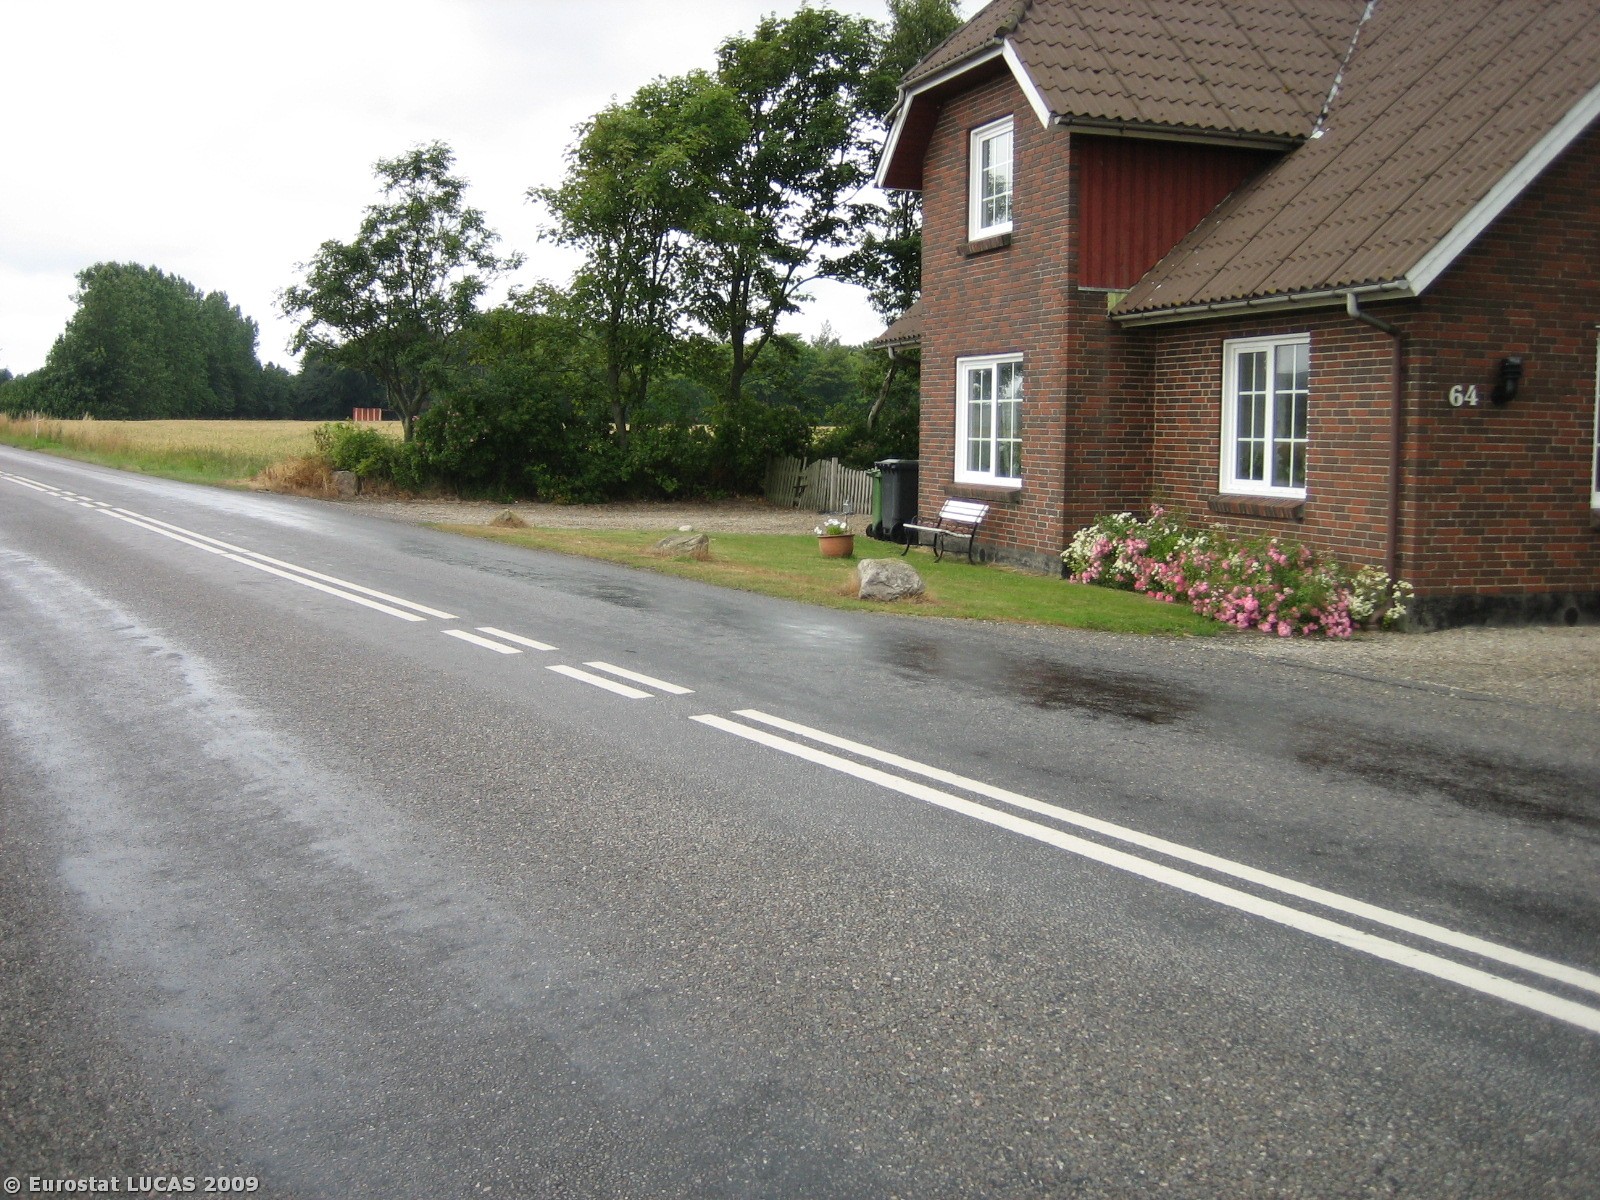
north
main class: Cropland
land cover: Common wheat
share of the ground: > 75 %
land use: Agriculture (excluding fallow land and kitchen gardens)
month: July
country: DK
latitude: 55.6380
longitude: 8.3652
